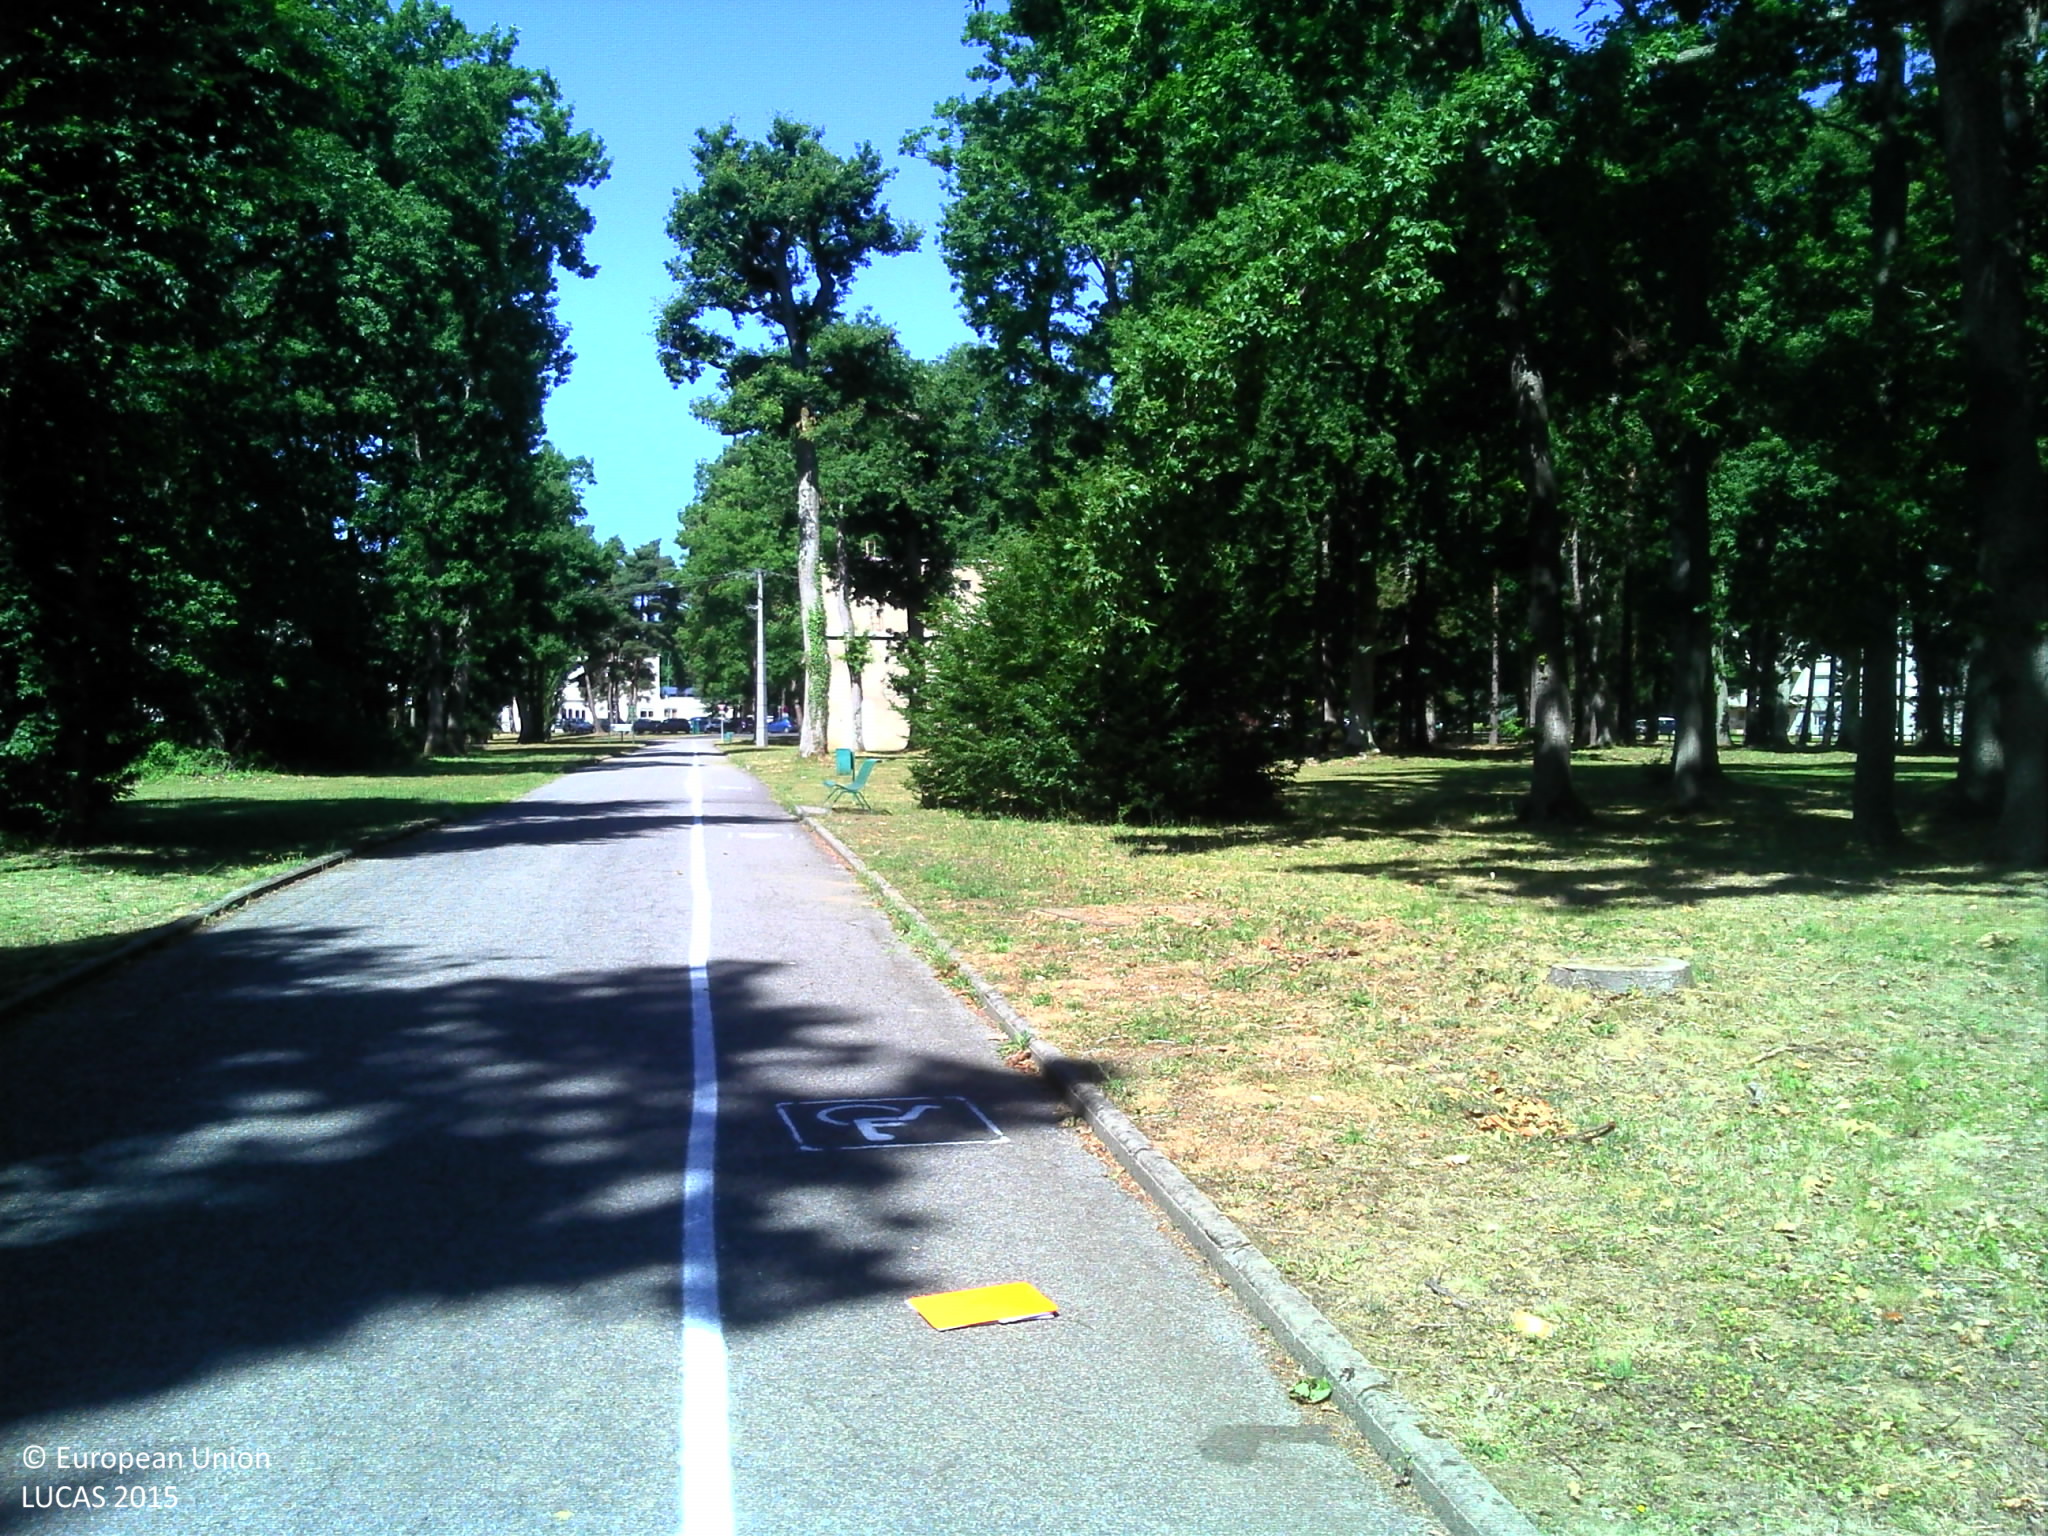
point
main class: Woodland
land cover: Broadleaved woodland
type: mesophytic deciduous forest
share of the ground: > 75 %
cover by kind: broadleaved forest trees 80 %, herbaceous plants 20 %
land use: Community services
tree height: > 5 m
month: June
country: FR
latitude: 49.0017
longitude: 1.0803
